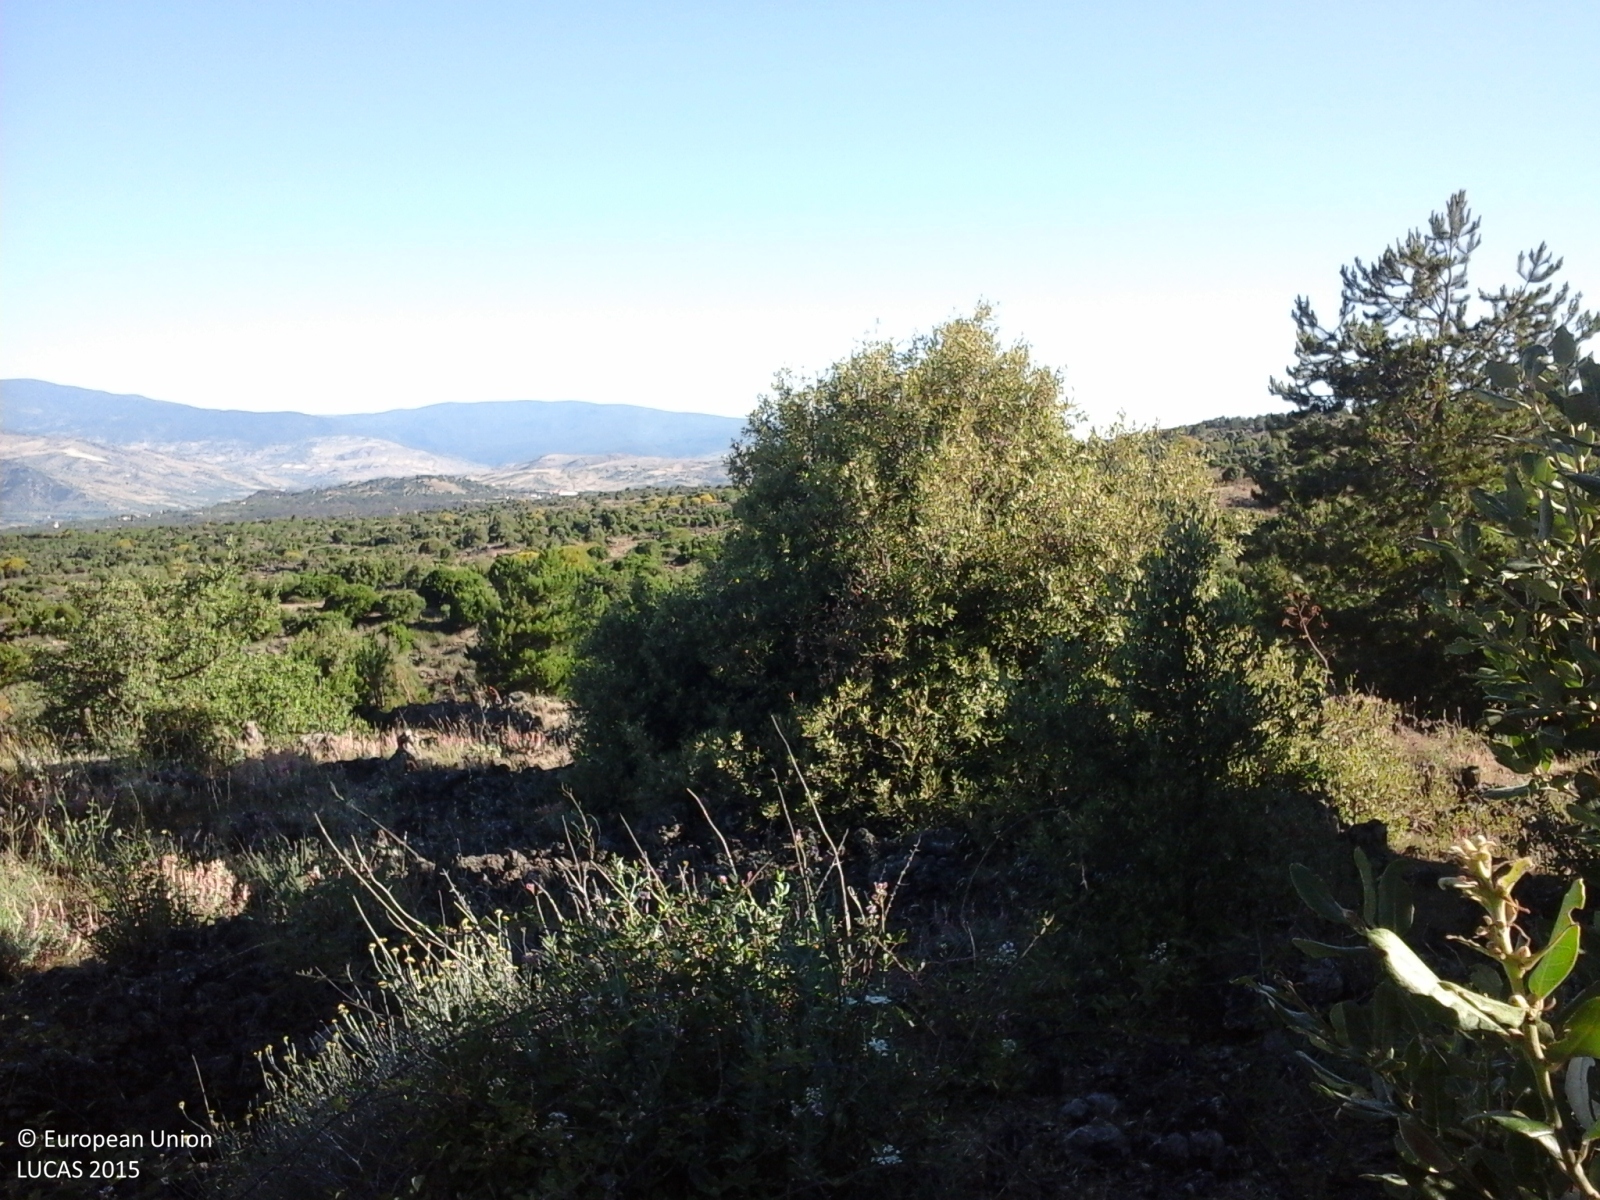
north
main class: Woodland
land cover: Broadleaved woodland
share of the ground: > 75 %
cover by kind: broadleaved forest trees 60 %, shrubs 20 %, coniferous forest trees 10 %, herbaceous plants 5 %, unconsolidated bare surface 5 %
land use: Amenities, museums, leisure
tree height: < 5 m
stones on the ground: > 50 %
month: June
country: IT
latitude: 37.7325
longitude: 14.8565
